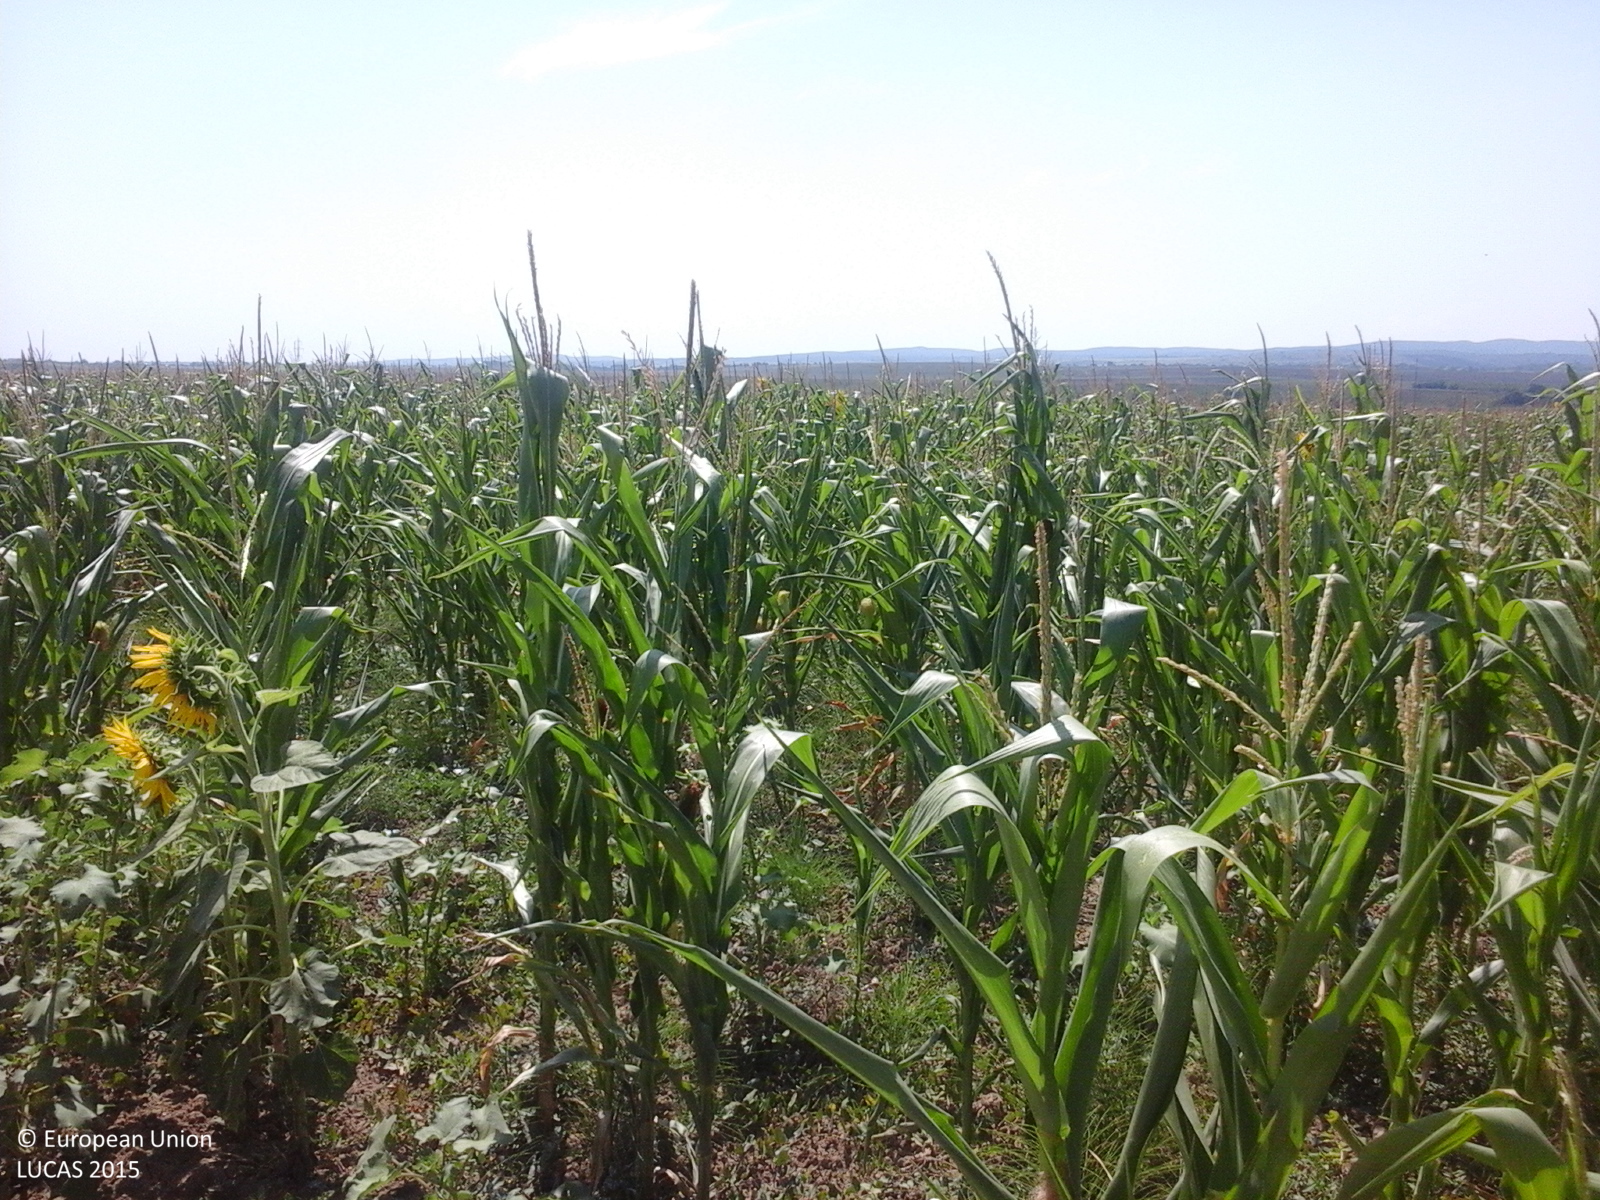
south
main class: Cropland
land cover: Maize
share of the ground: > 75 %
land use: Agriculture (excluding fallow land and kitchen gardens)
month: August
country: RO
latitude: 46.2700
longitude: 27.0817
